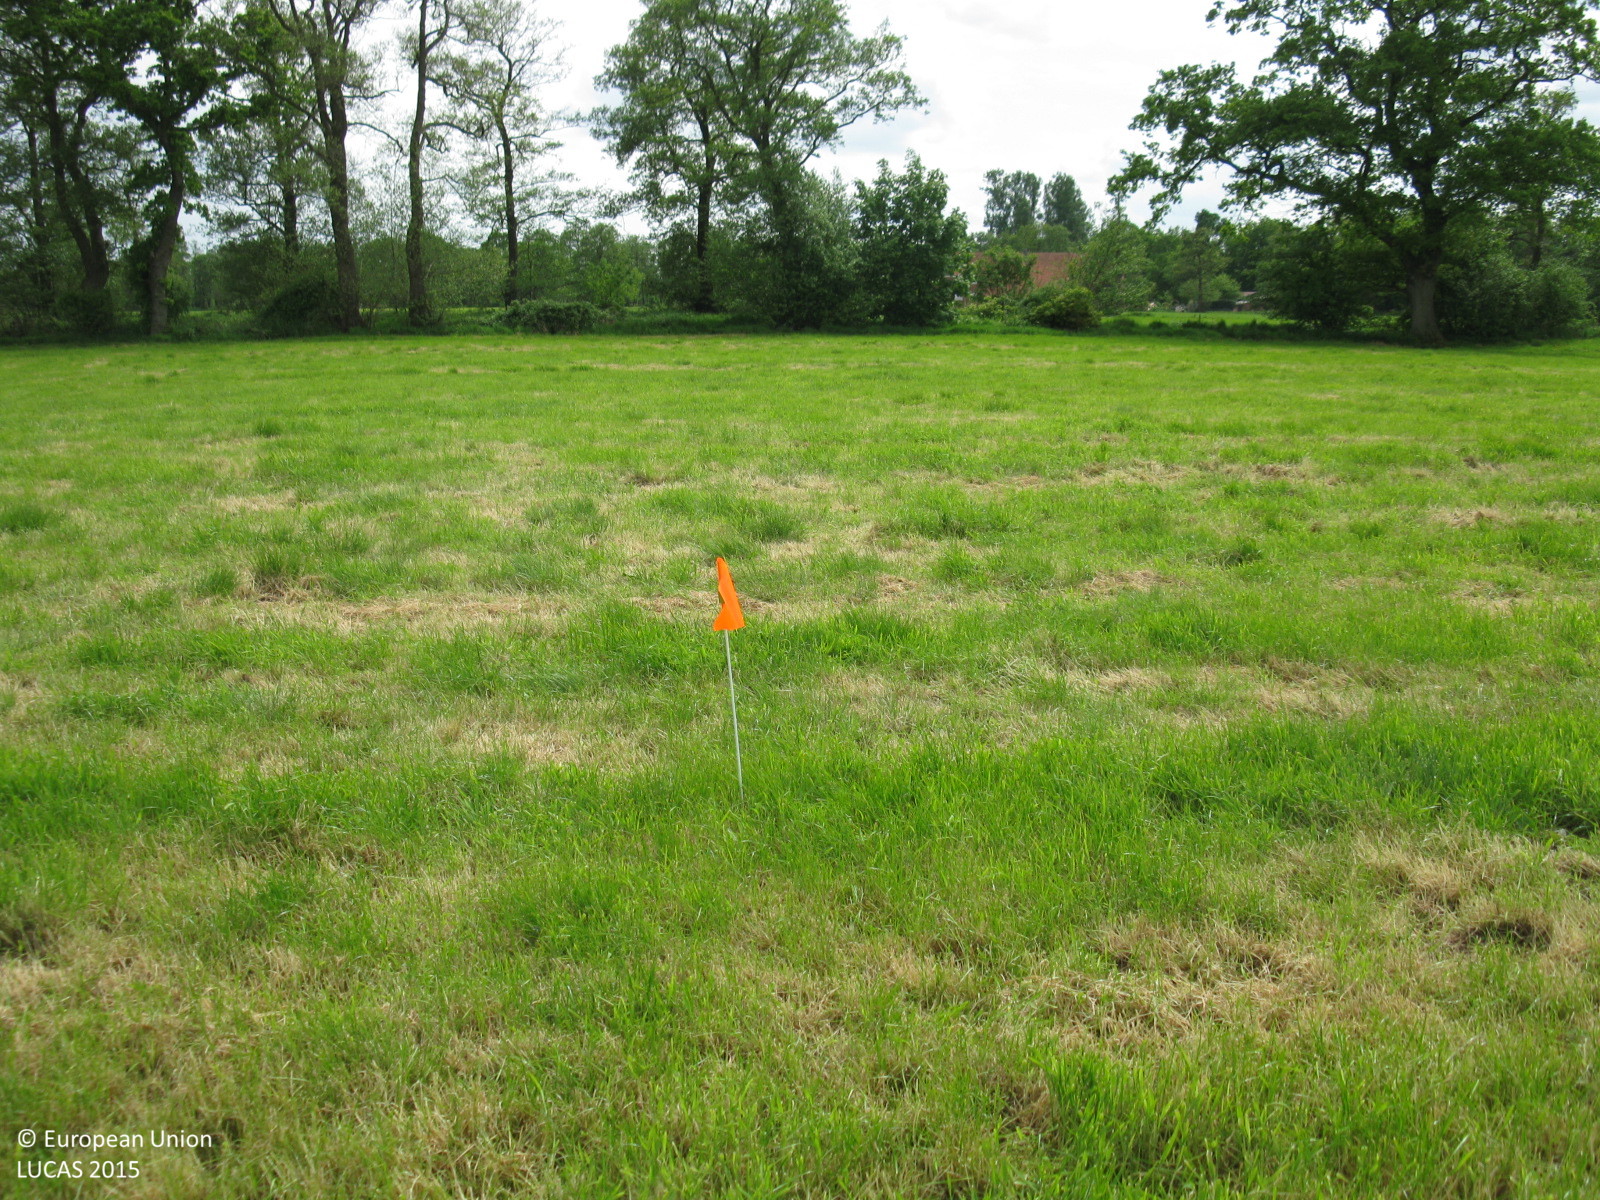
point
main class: Grassland
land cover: Grassland without tree/shrub cover
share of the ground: > 75 %
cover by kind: herbaceous plants 100 %
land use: Agriculture (excluding fallow land and kitchen gardens)
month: June
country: DE
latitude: 53.1207
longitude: 7.3258
